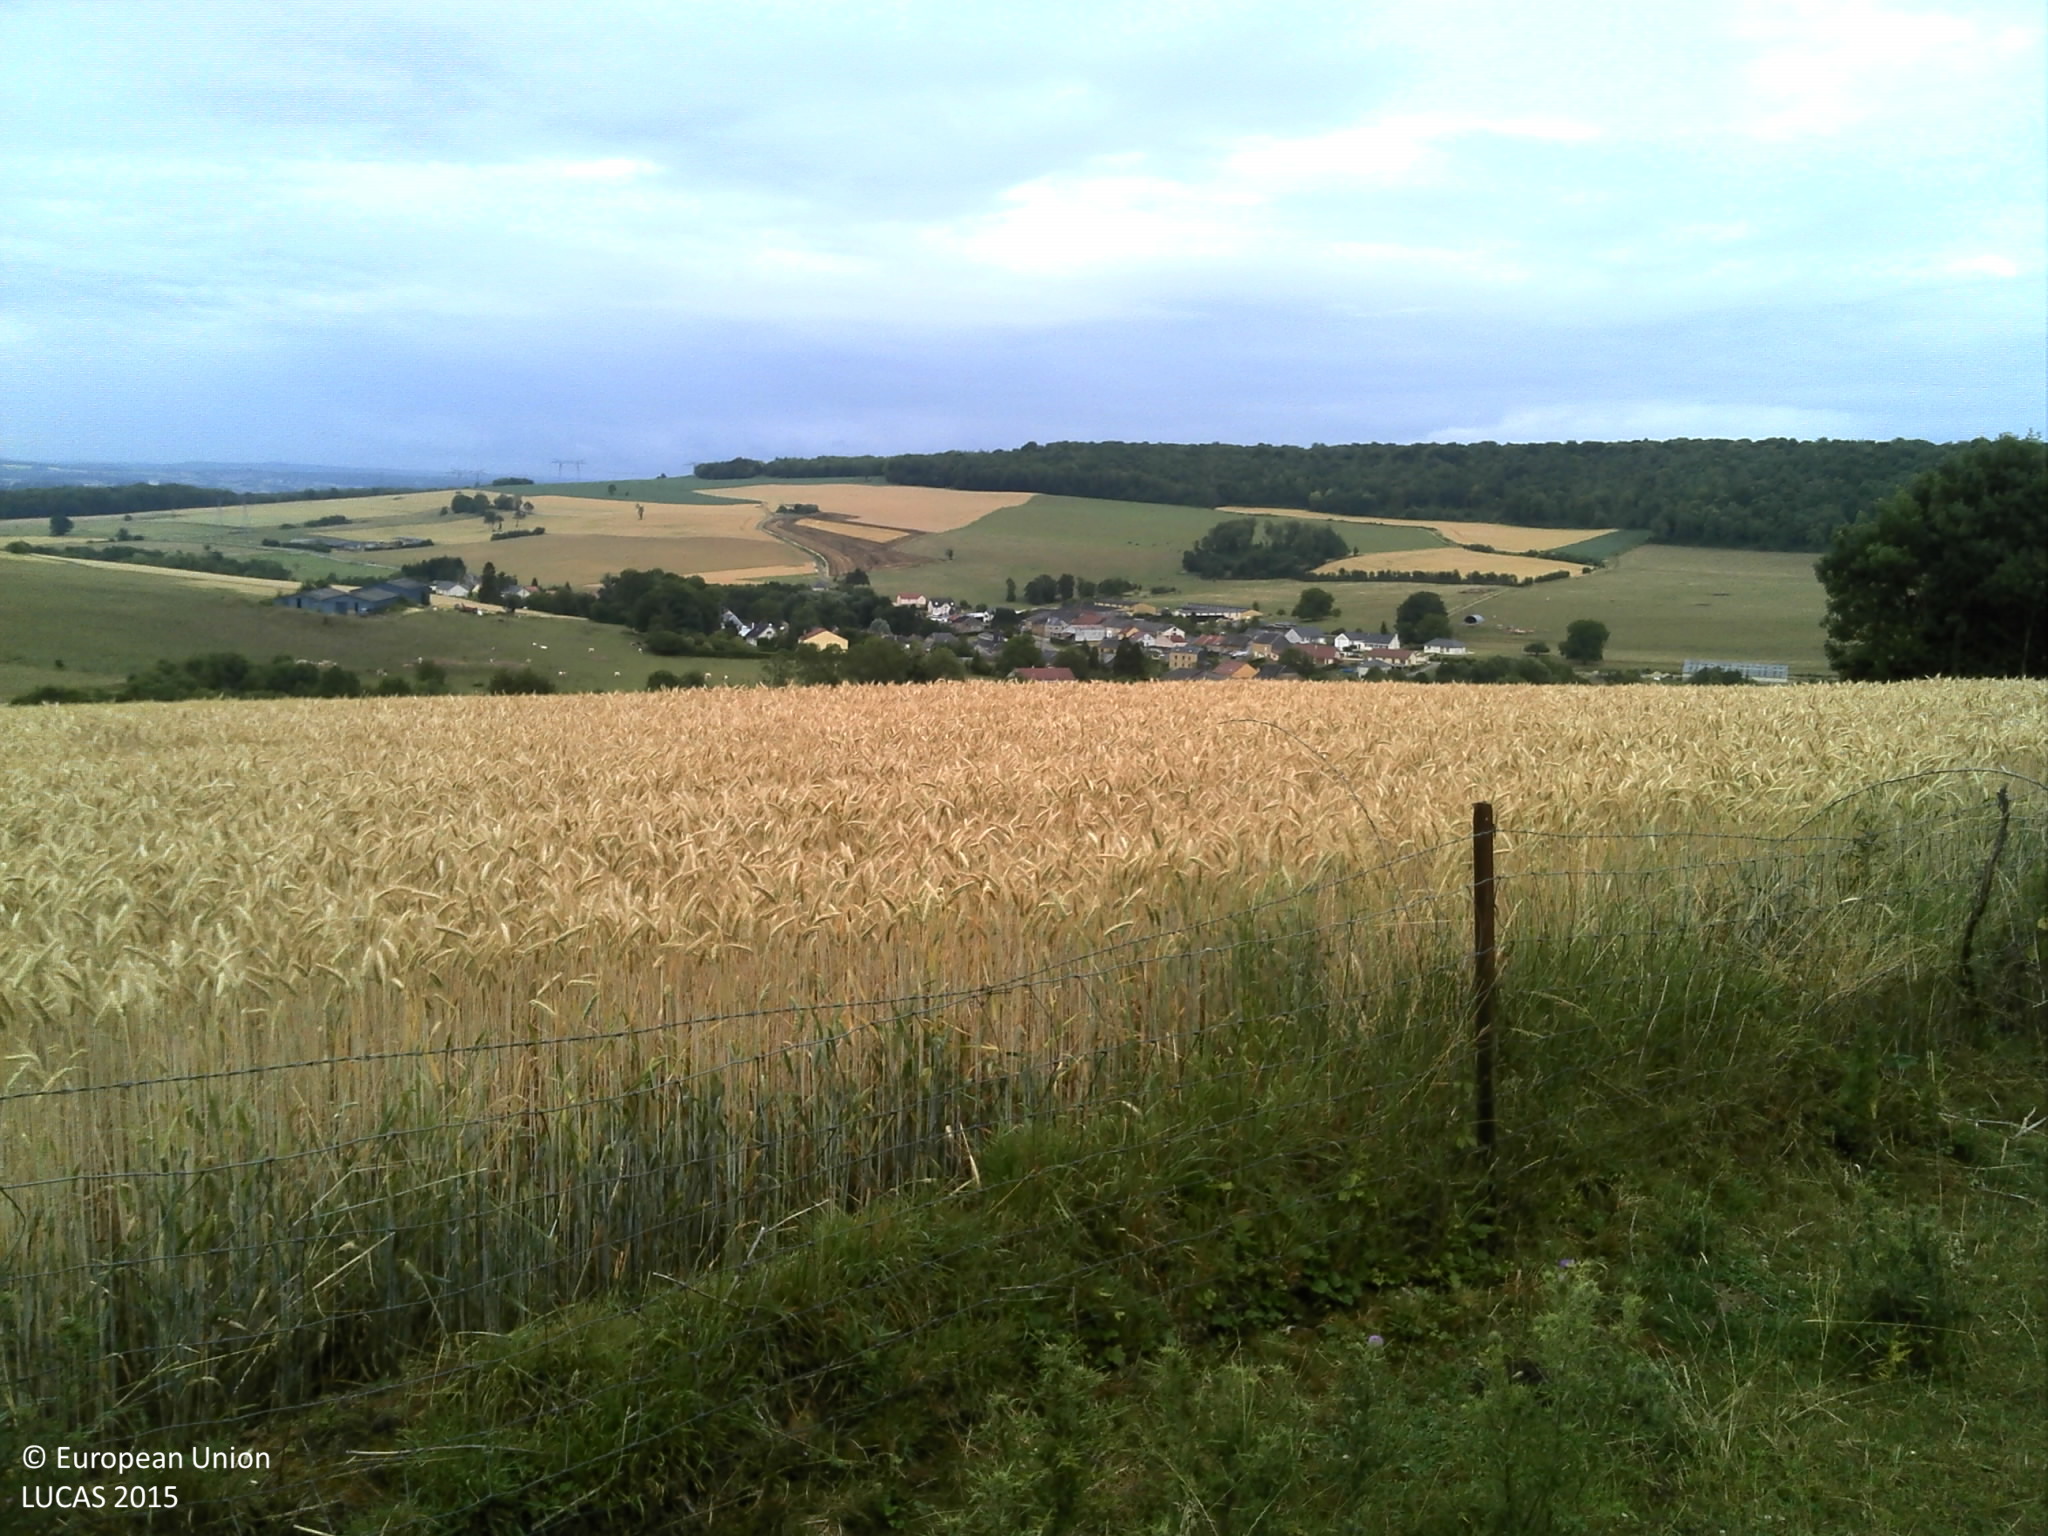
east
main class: Grassland
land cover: Grassland without tree/shrub cover
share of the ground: > 75 %
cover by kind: herbaceous plants 100 %
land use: Agriculture (excluding fallow land and kitchen gardens)
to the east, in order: Grassland without tree/shrub cover; Fences; Common wheat; Maize; Fences; Common wheat
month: July
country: FR
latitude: 49.7498
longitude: 4.5975
